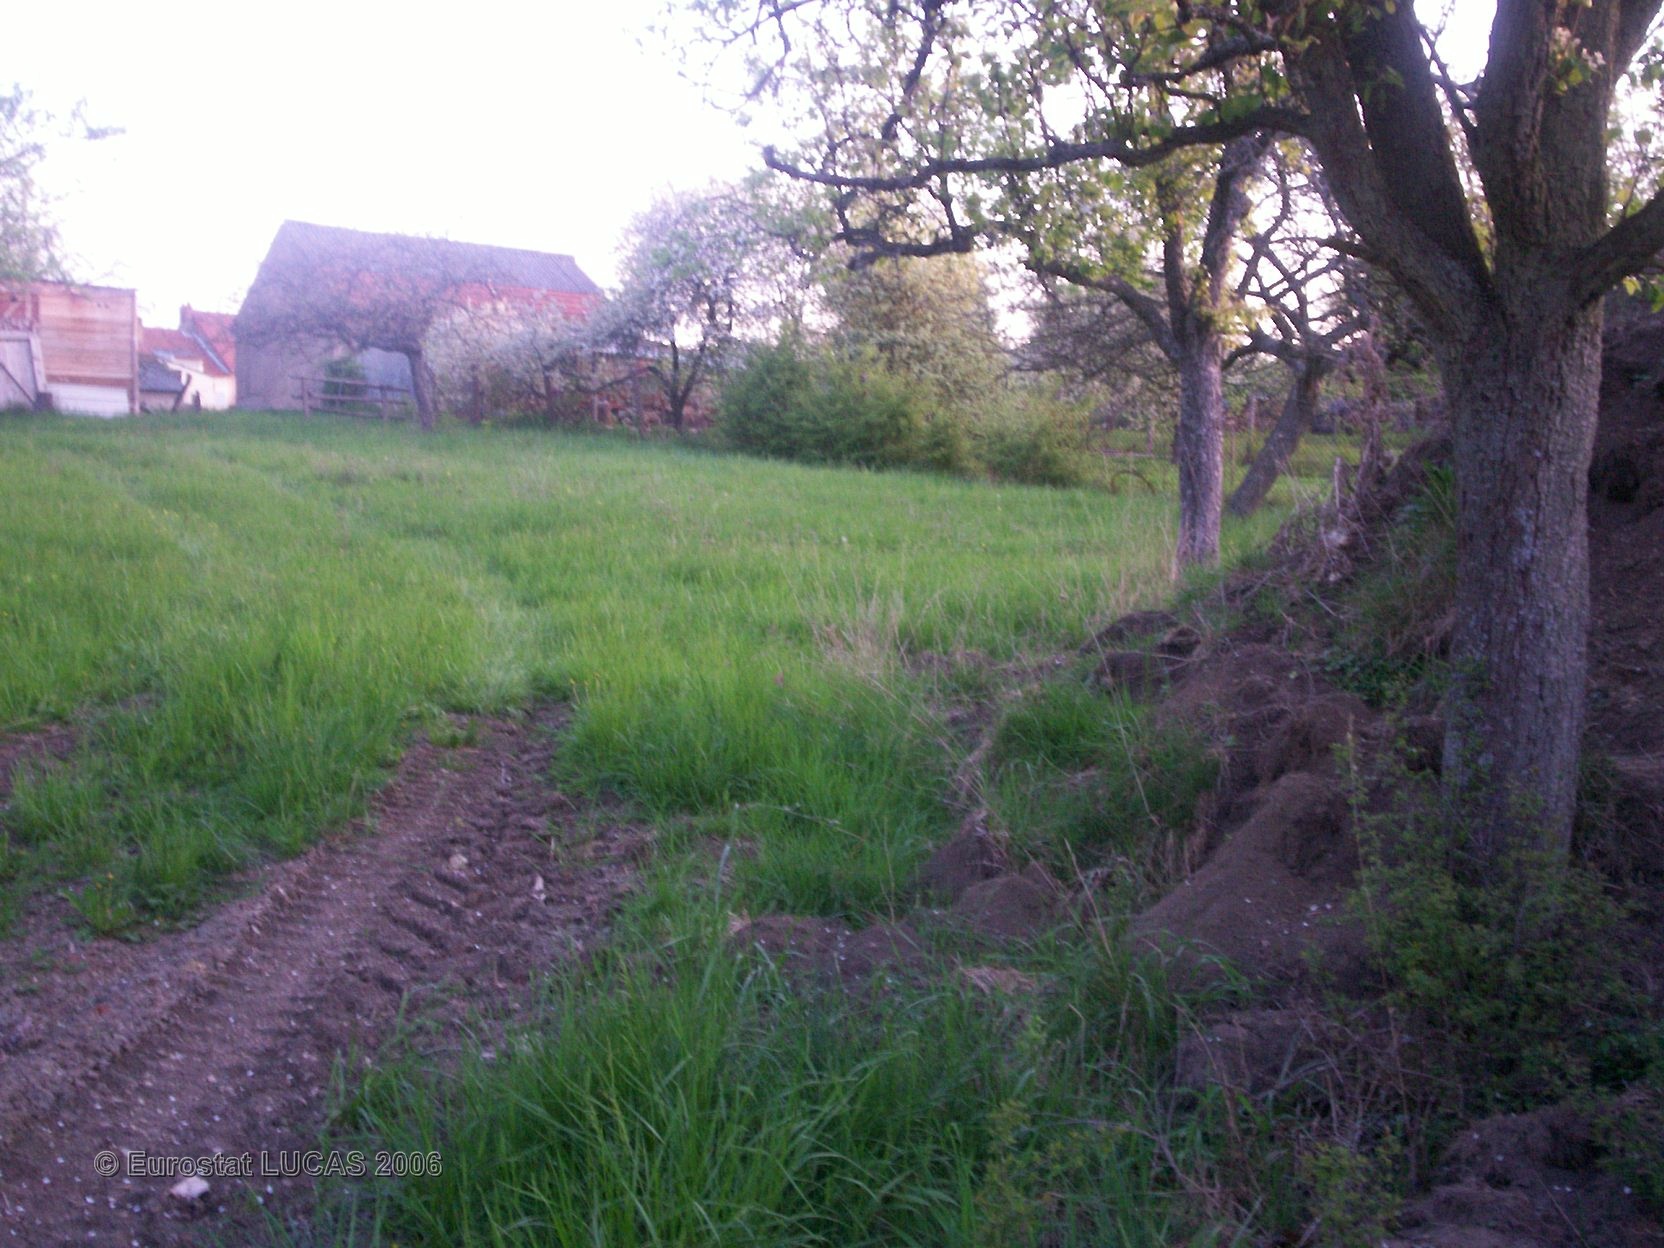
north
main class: Cropland
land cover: Apple fruit
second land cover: Grassland with sparse tree/shrub cover
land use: Agriculture (excluding fallow land and kitchen gardens)
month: May
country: FR
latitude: 49.0463
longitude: 6.9768
